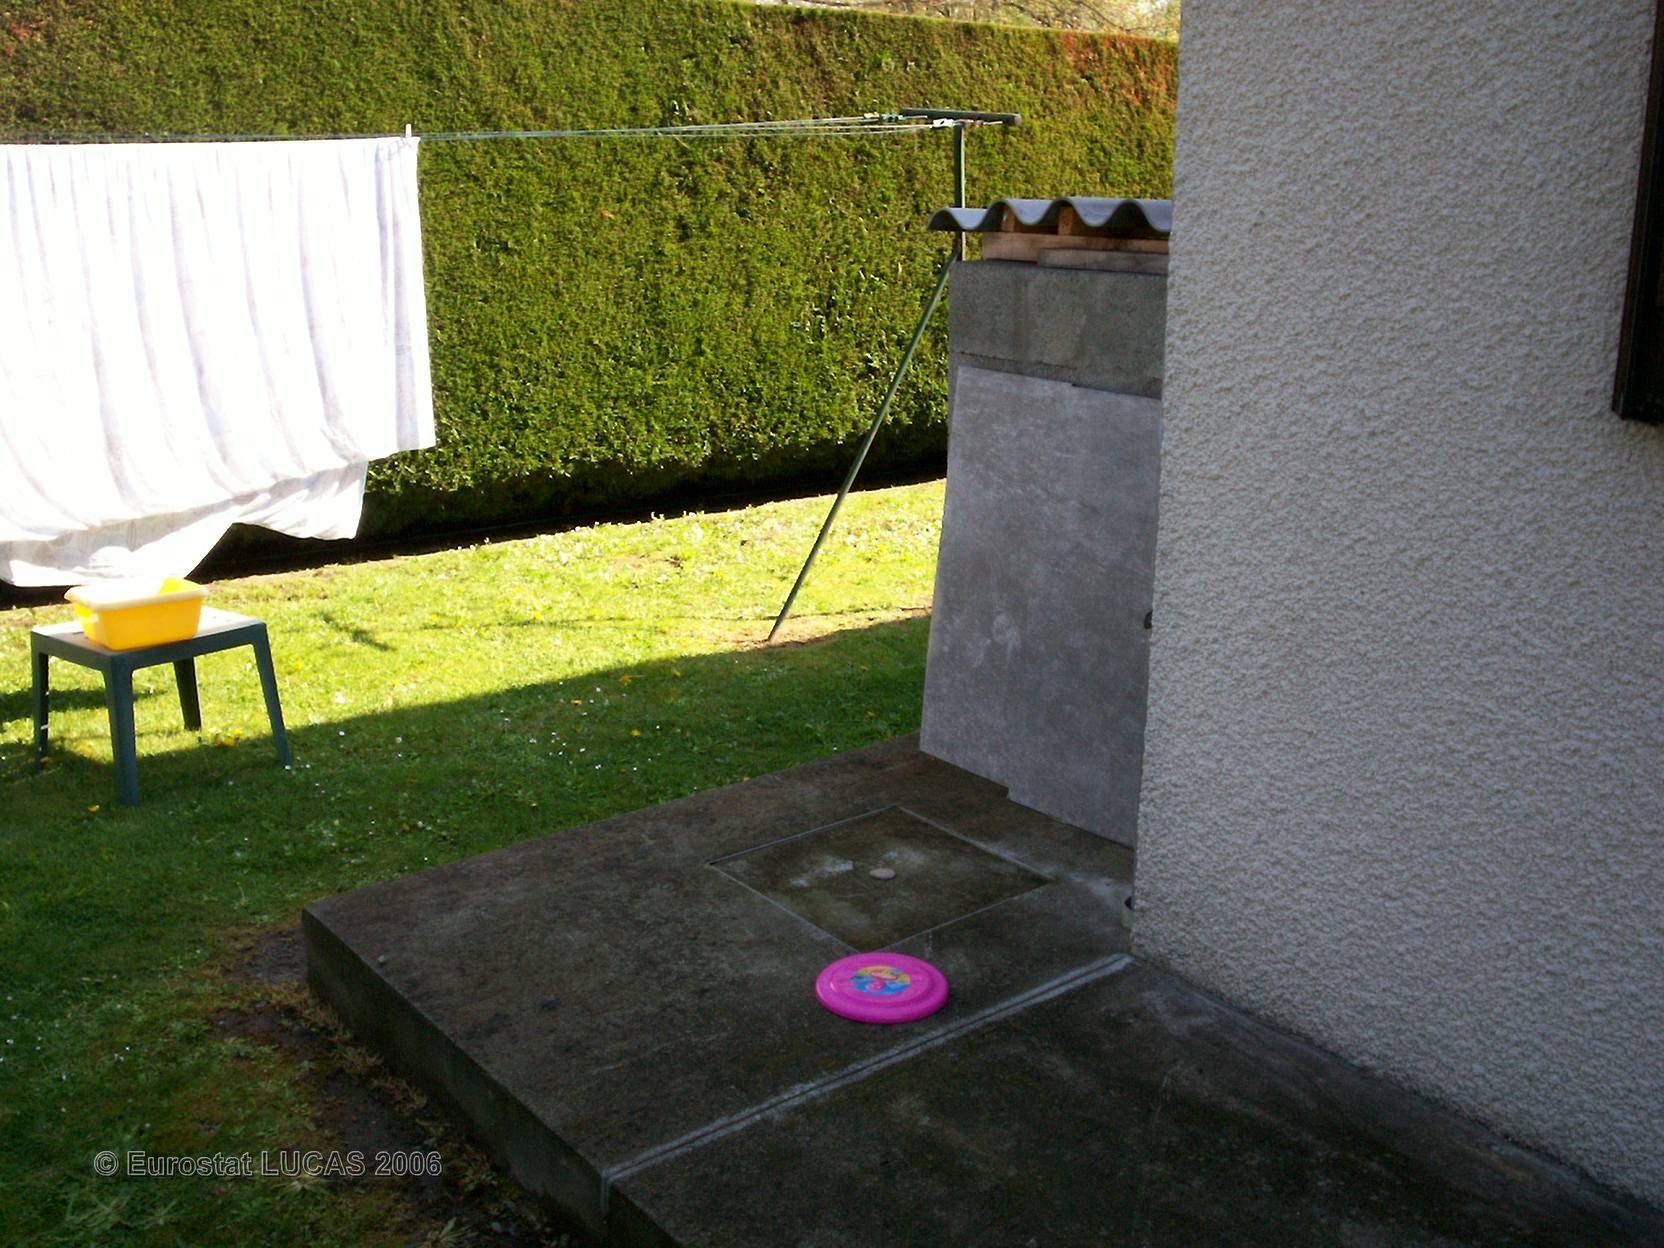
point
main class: Grassland
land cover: Grassland without tree/shrub cover
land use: Residential
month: April
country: FR
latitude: 43.3914
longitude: -0.3900
